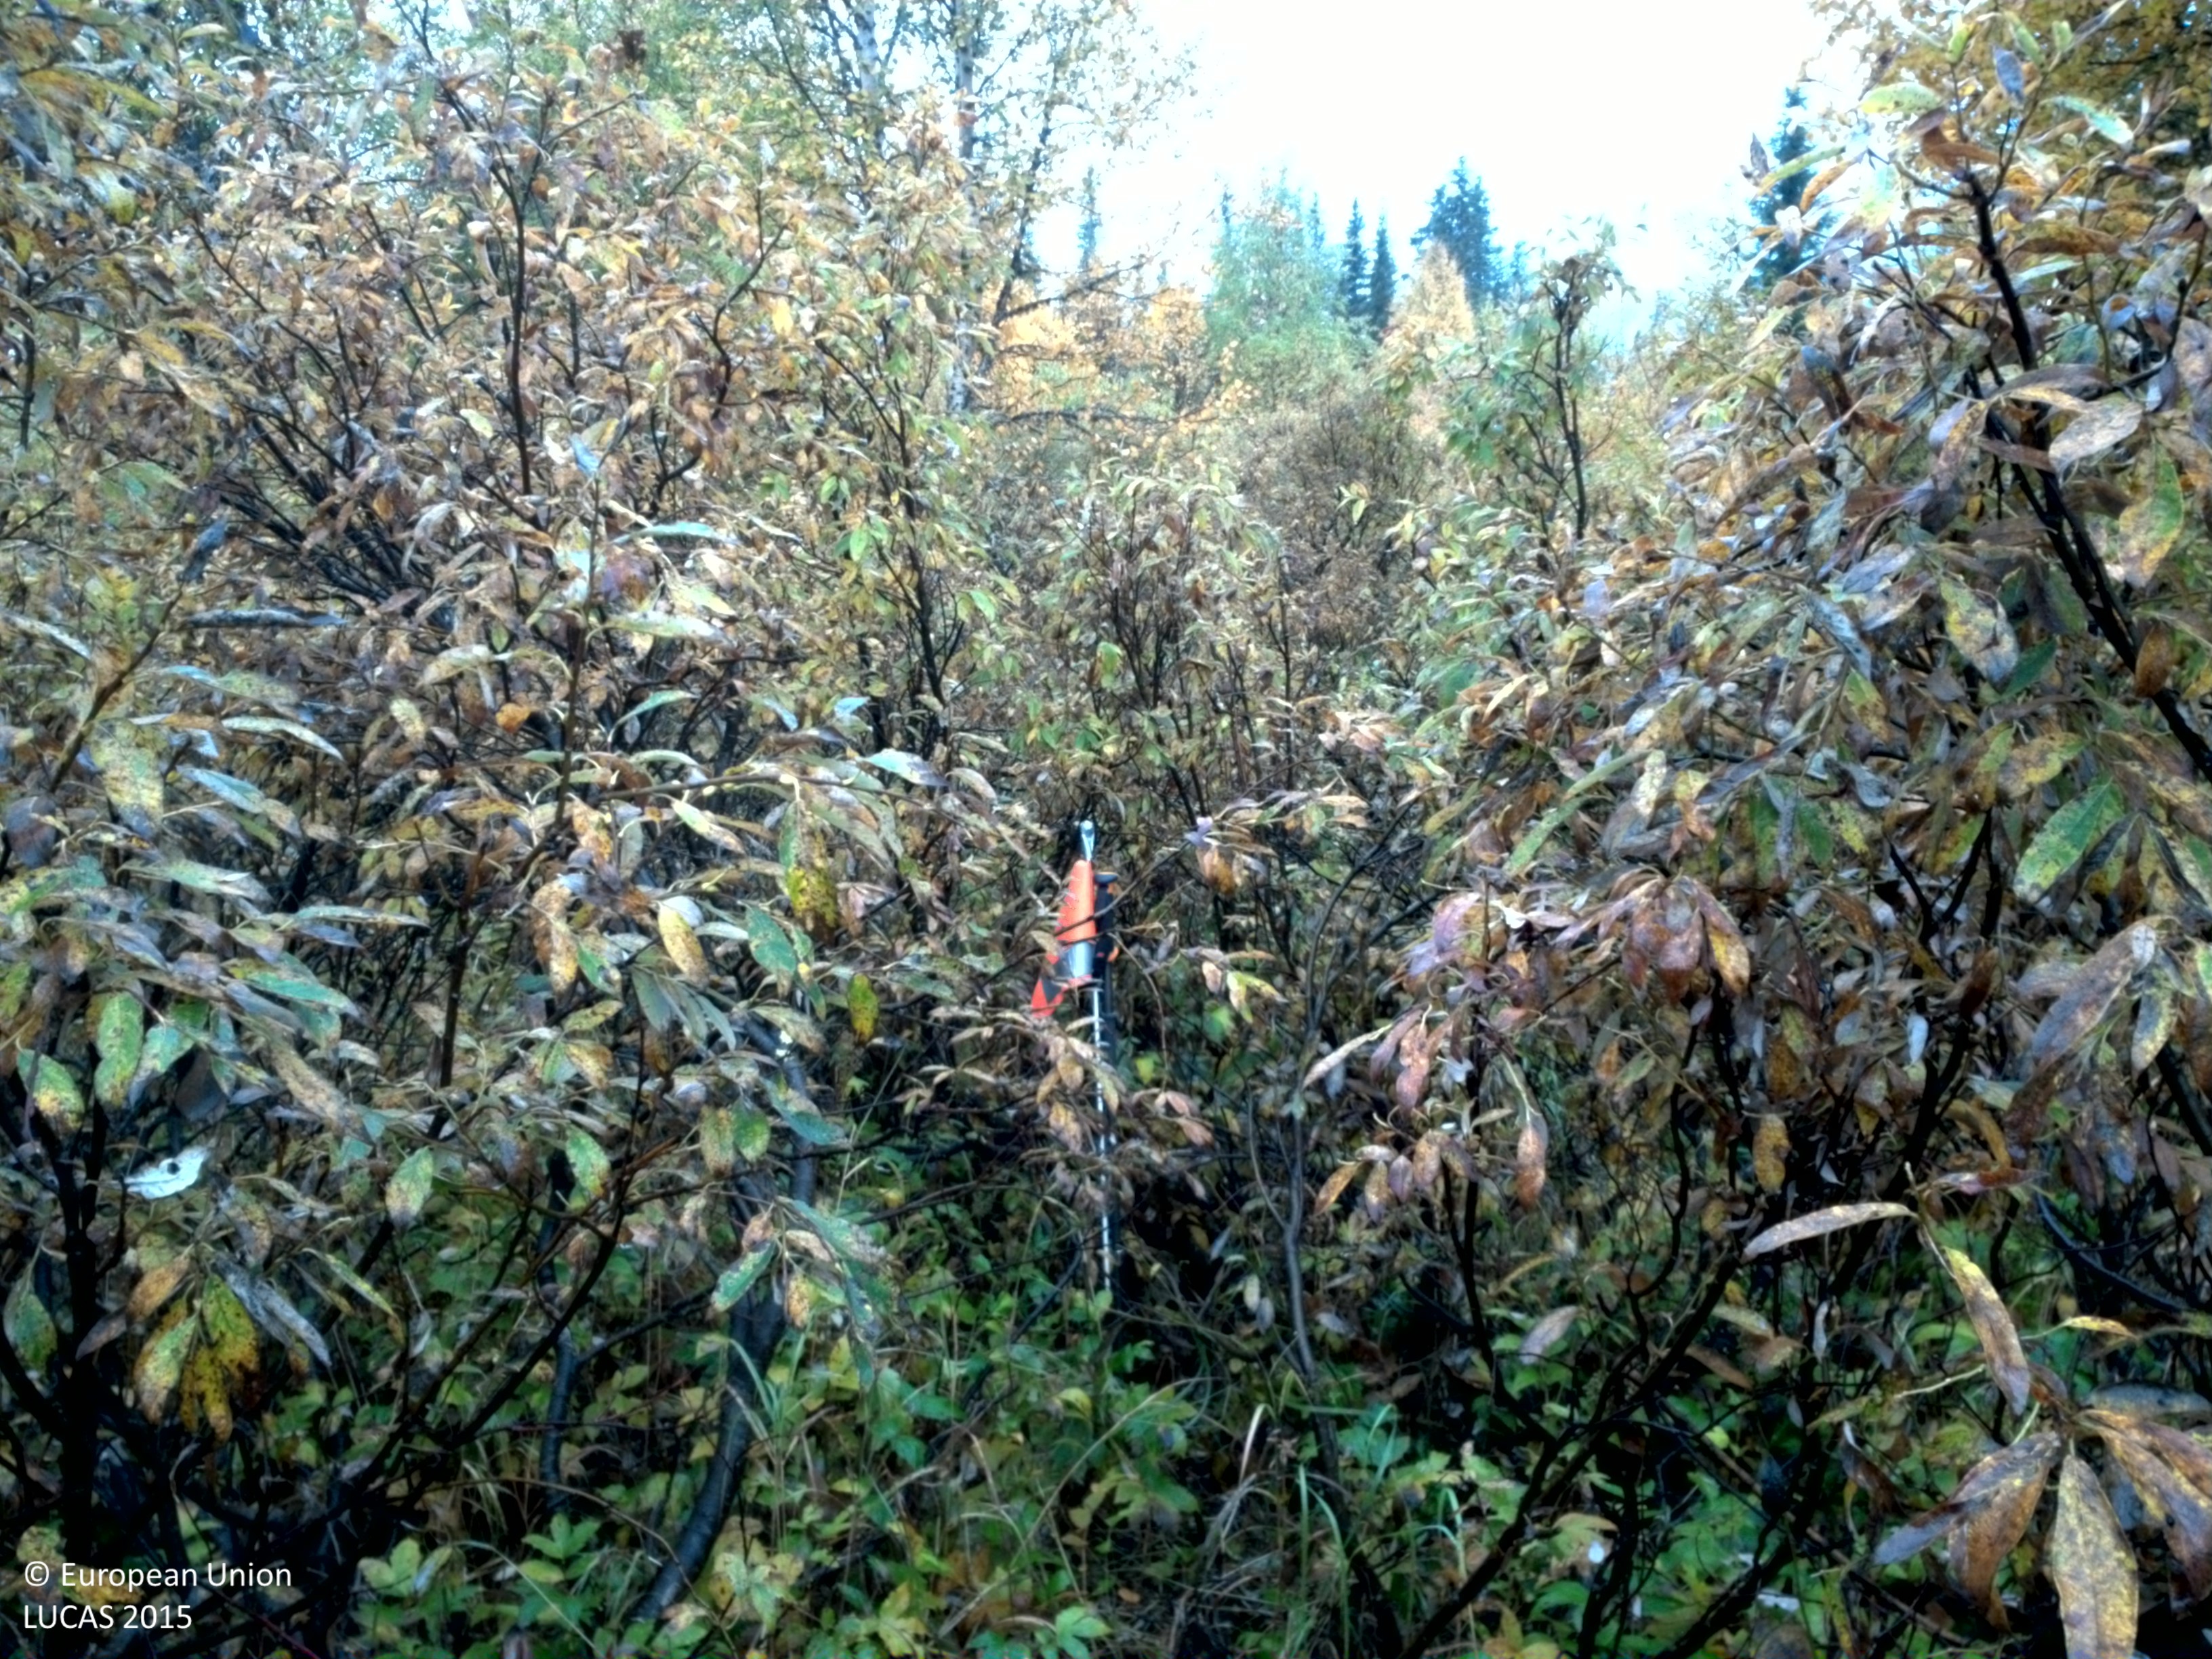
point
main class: Shrubland
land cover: Shrubland with sparse tree cover
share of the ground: > 75 %
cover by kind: shrubs 85 %, herbaceous plants 10 %, broadleaved forest trees 5 %
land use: Semi-natural and natural areas not in use
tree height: > 5 m
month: September
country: SE
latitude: 65.3099
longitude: 16.2070
